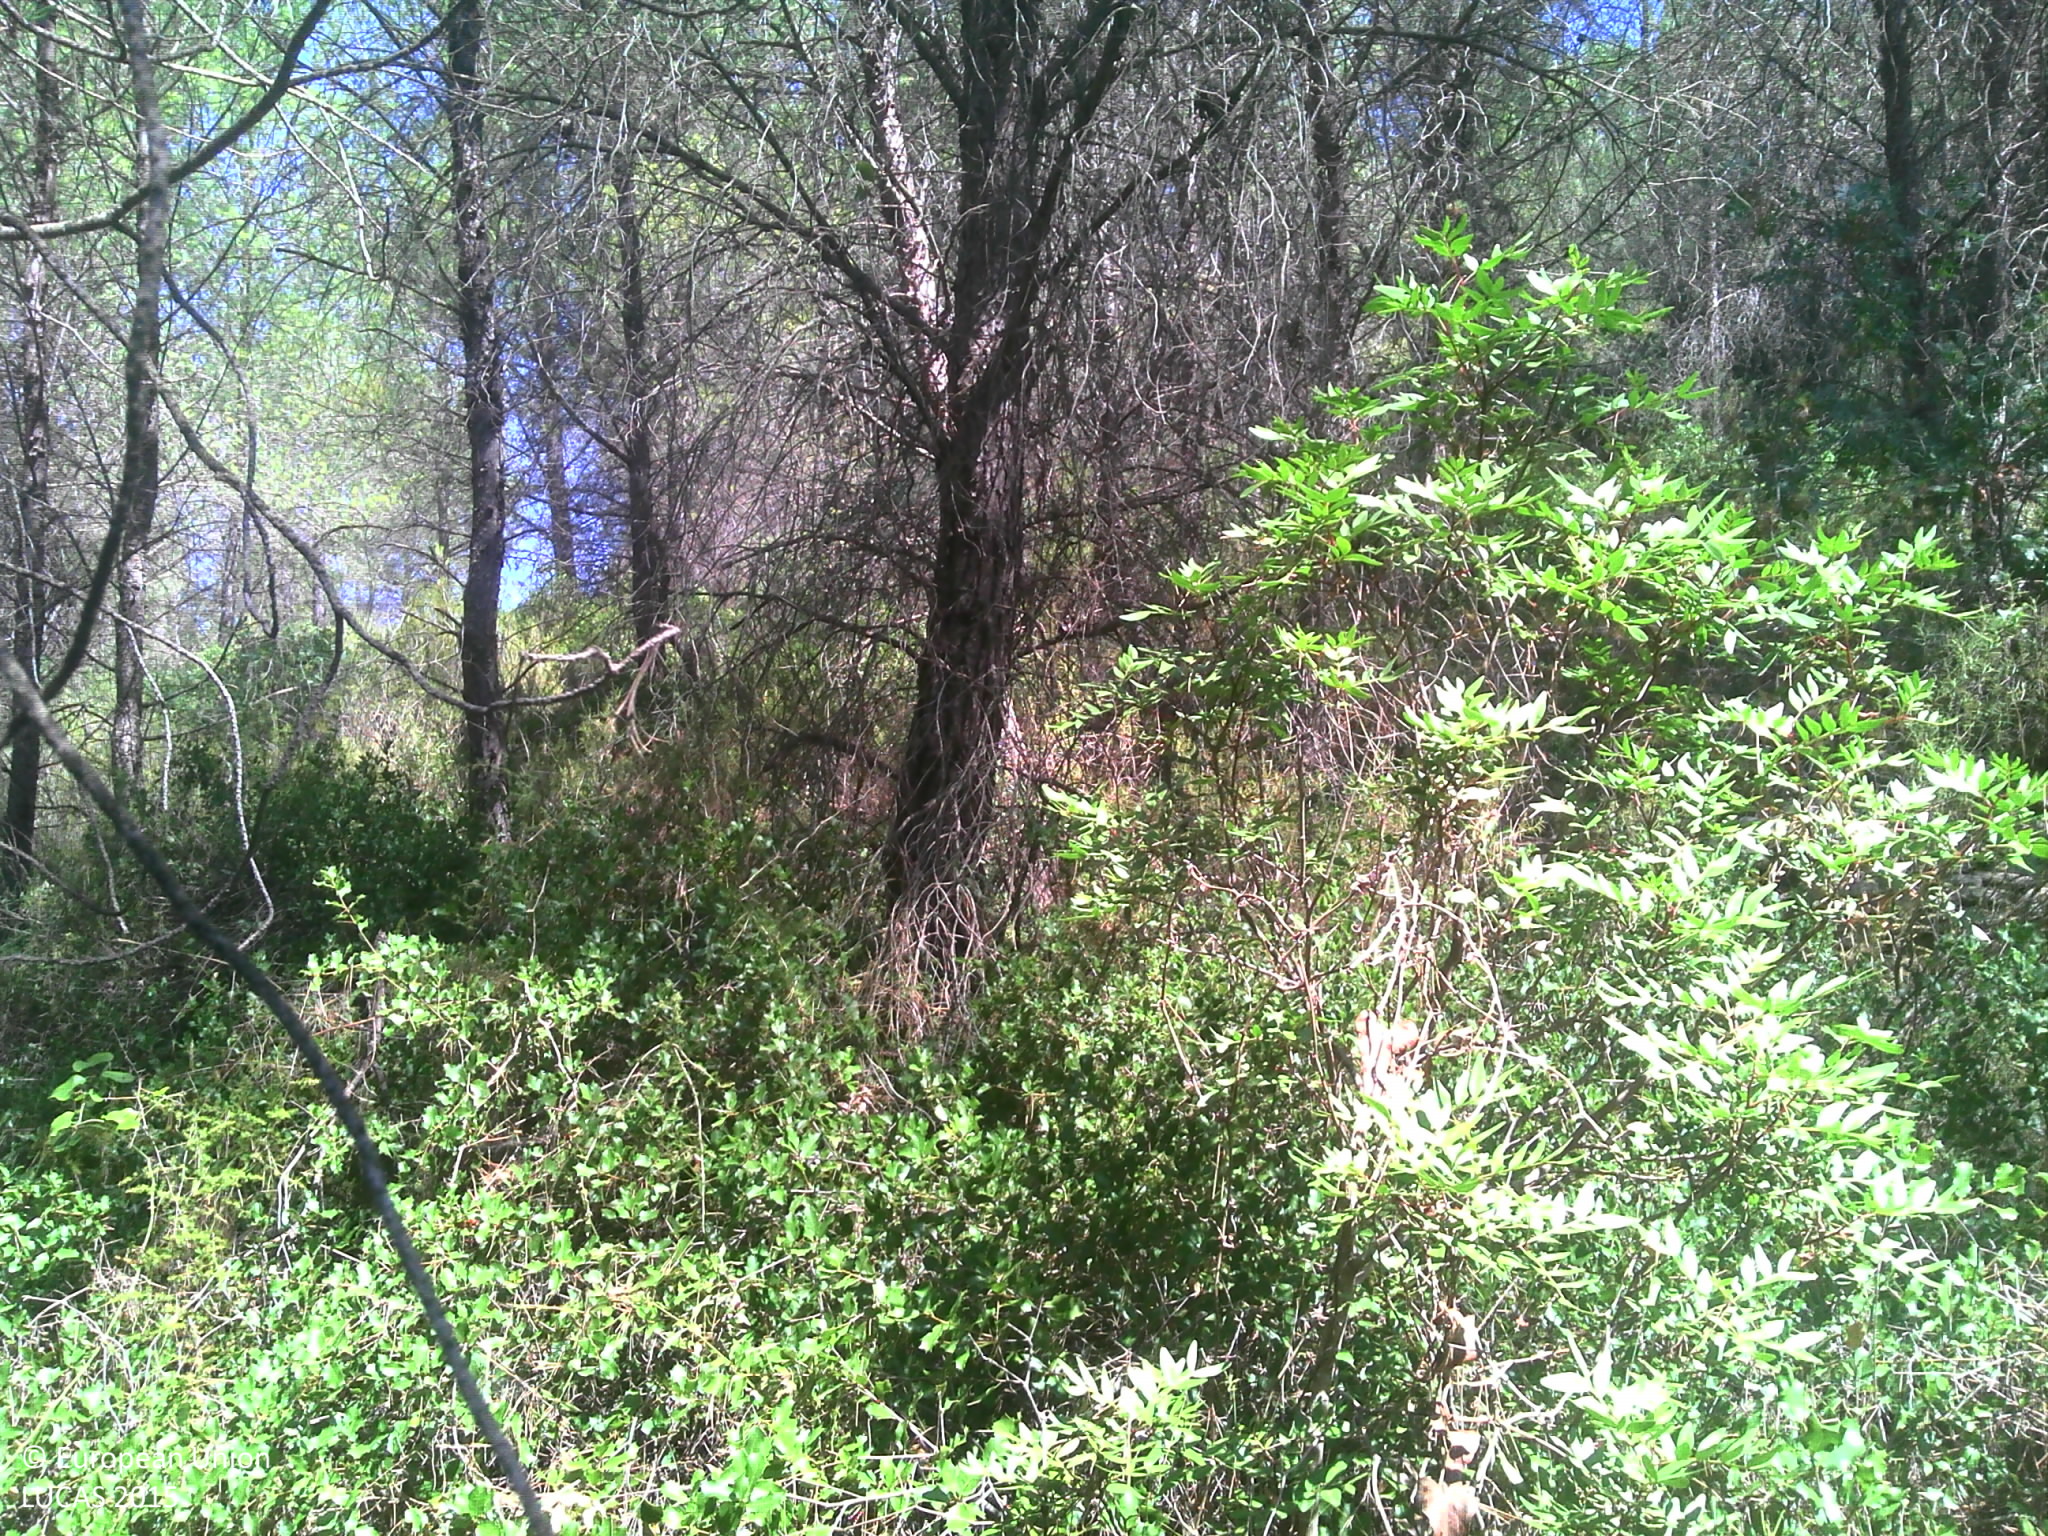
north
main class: Woodland
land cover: Pine dominated coniferous woodland
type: coniferous forest of the mediterranean region
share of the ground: > 75 %
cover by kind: coniferous forest trees 80 %, broadleaved forest trees 20 %
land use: Forestry
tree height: < 5 m
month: August
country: FR
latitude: 43.2090
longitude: 5.5917
